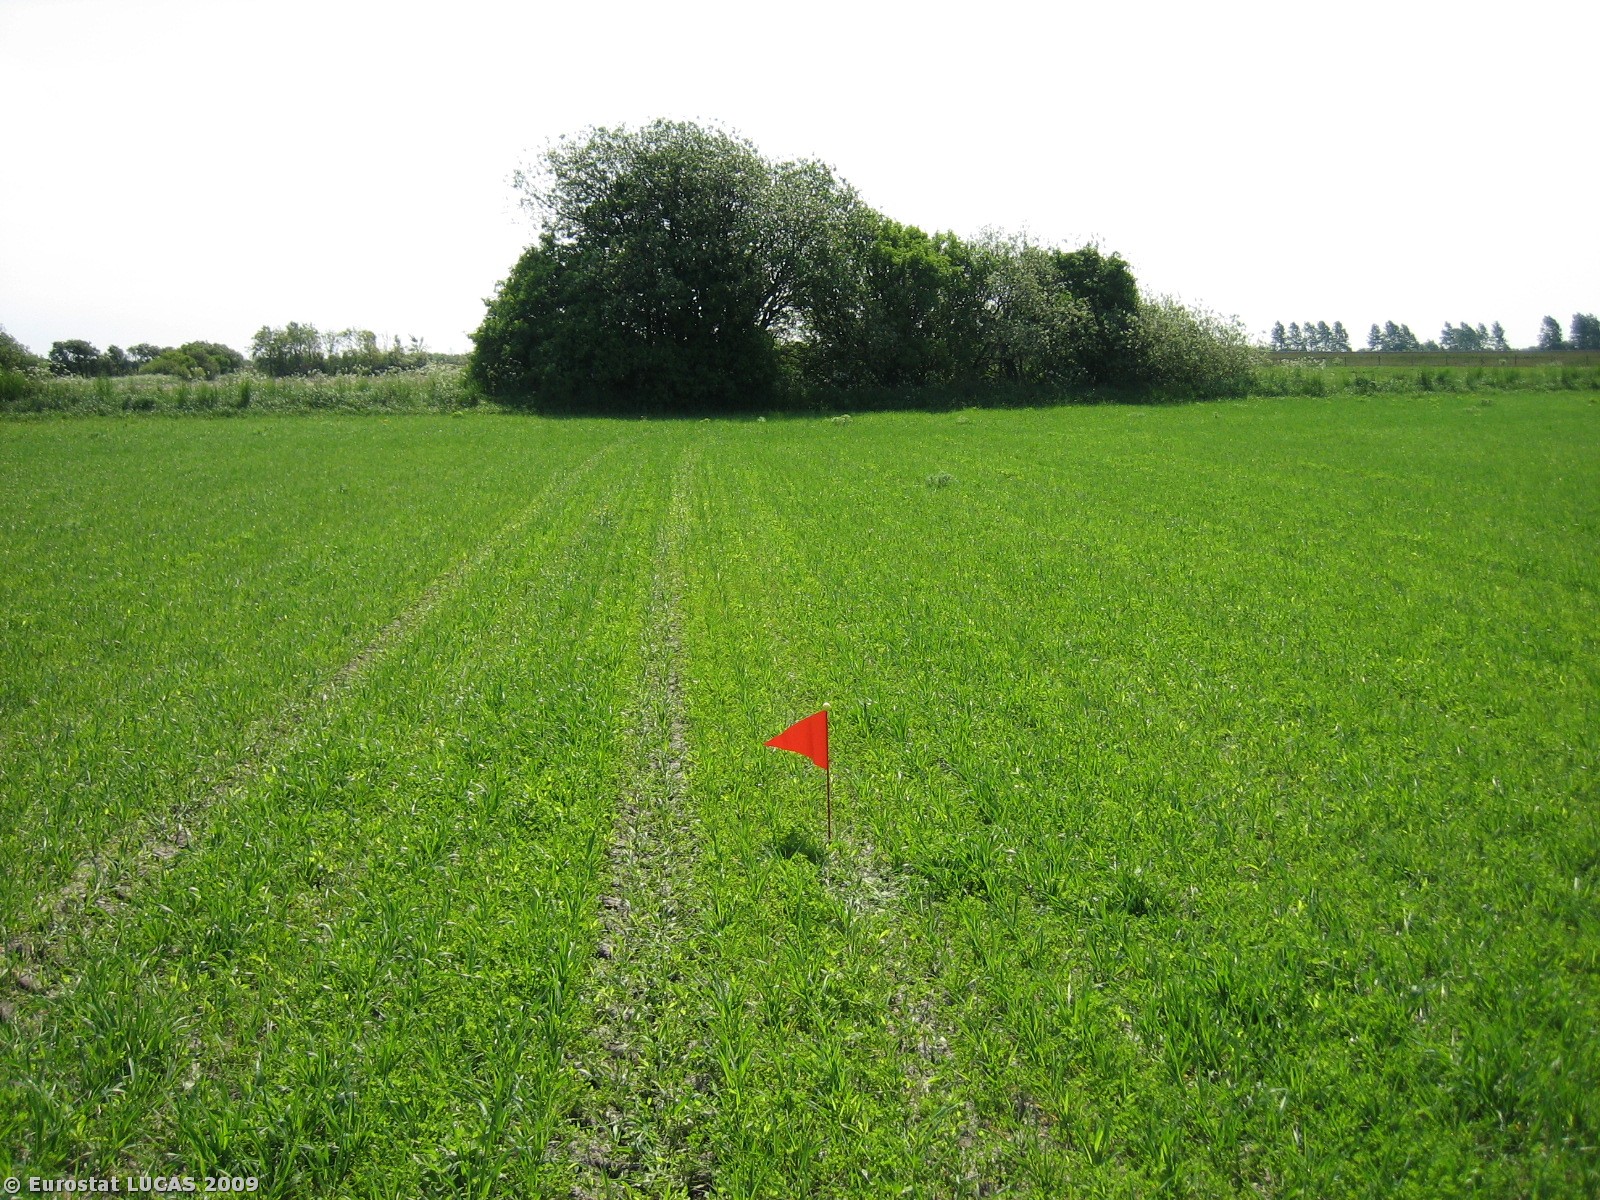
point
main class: Cropland
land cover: Barley
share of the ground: 50 - 75 %
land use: Agriculture (excluding fallow land and kitchen gardens)
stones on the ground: < 10 %
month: May
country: DK
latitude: 56.1314
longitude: 9.2125
